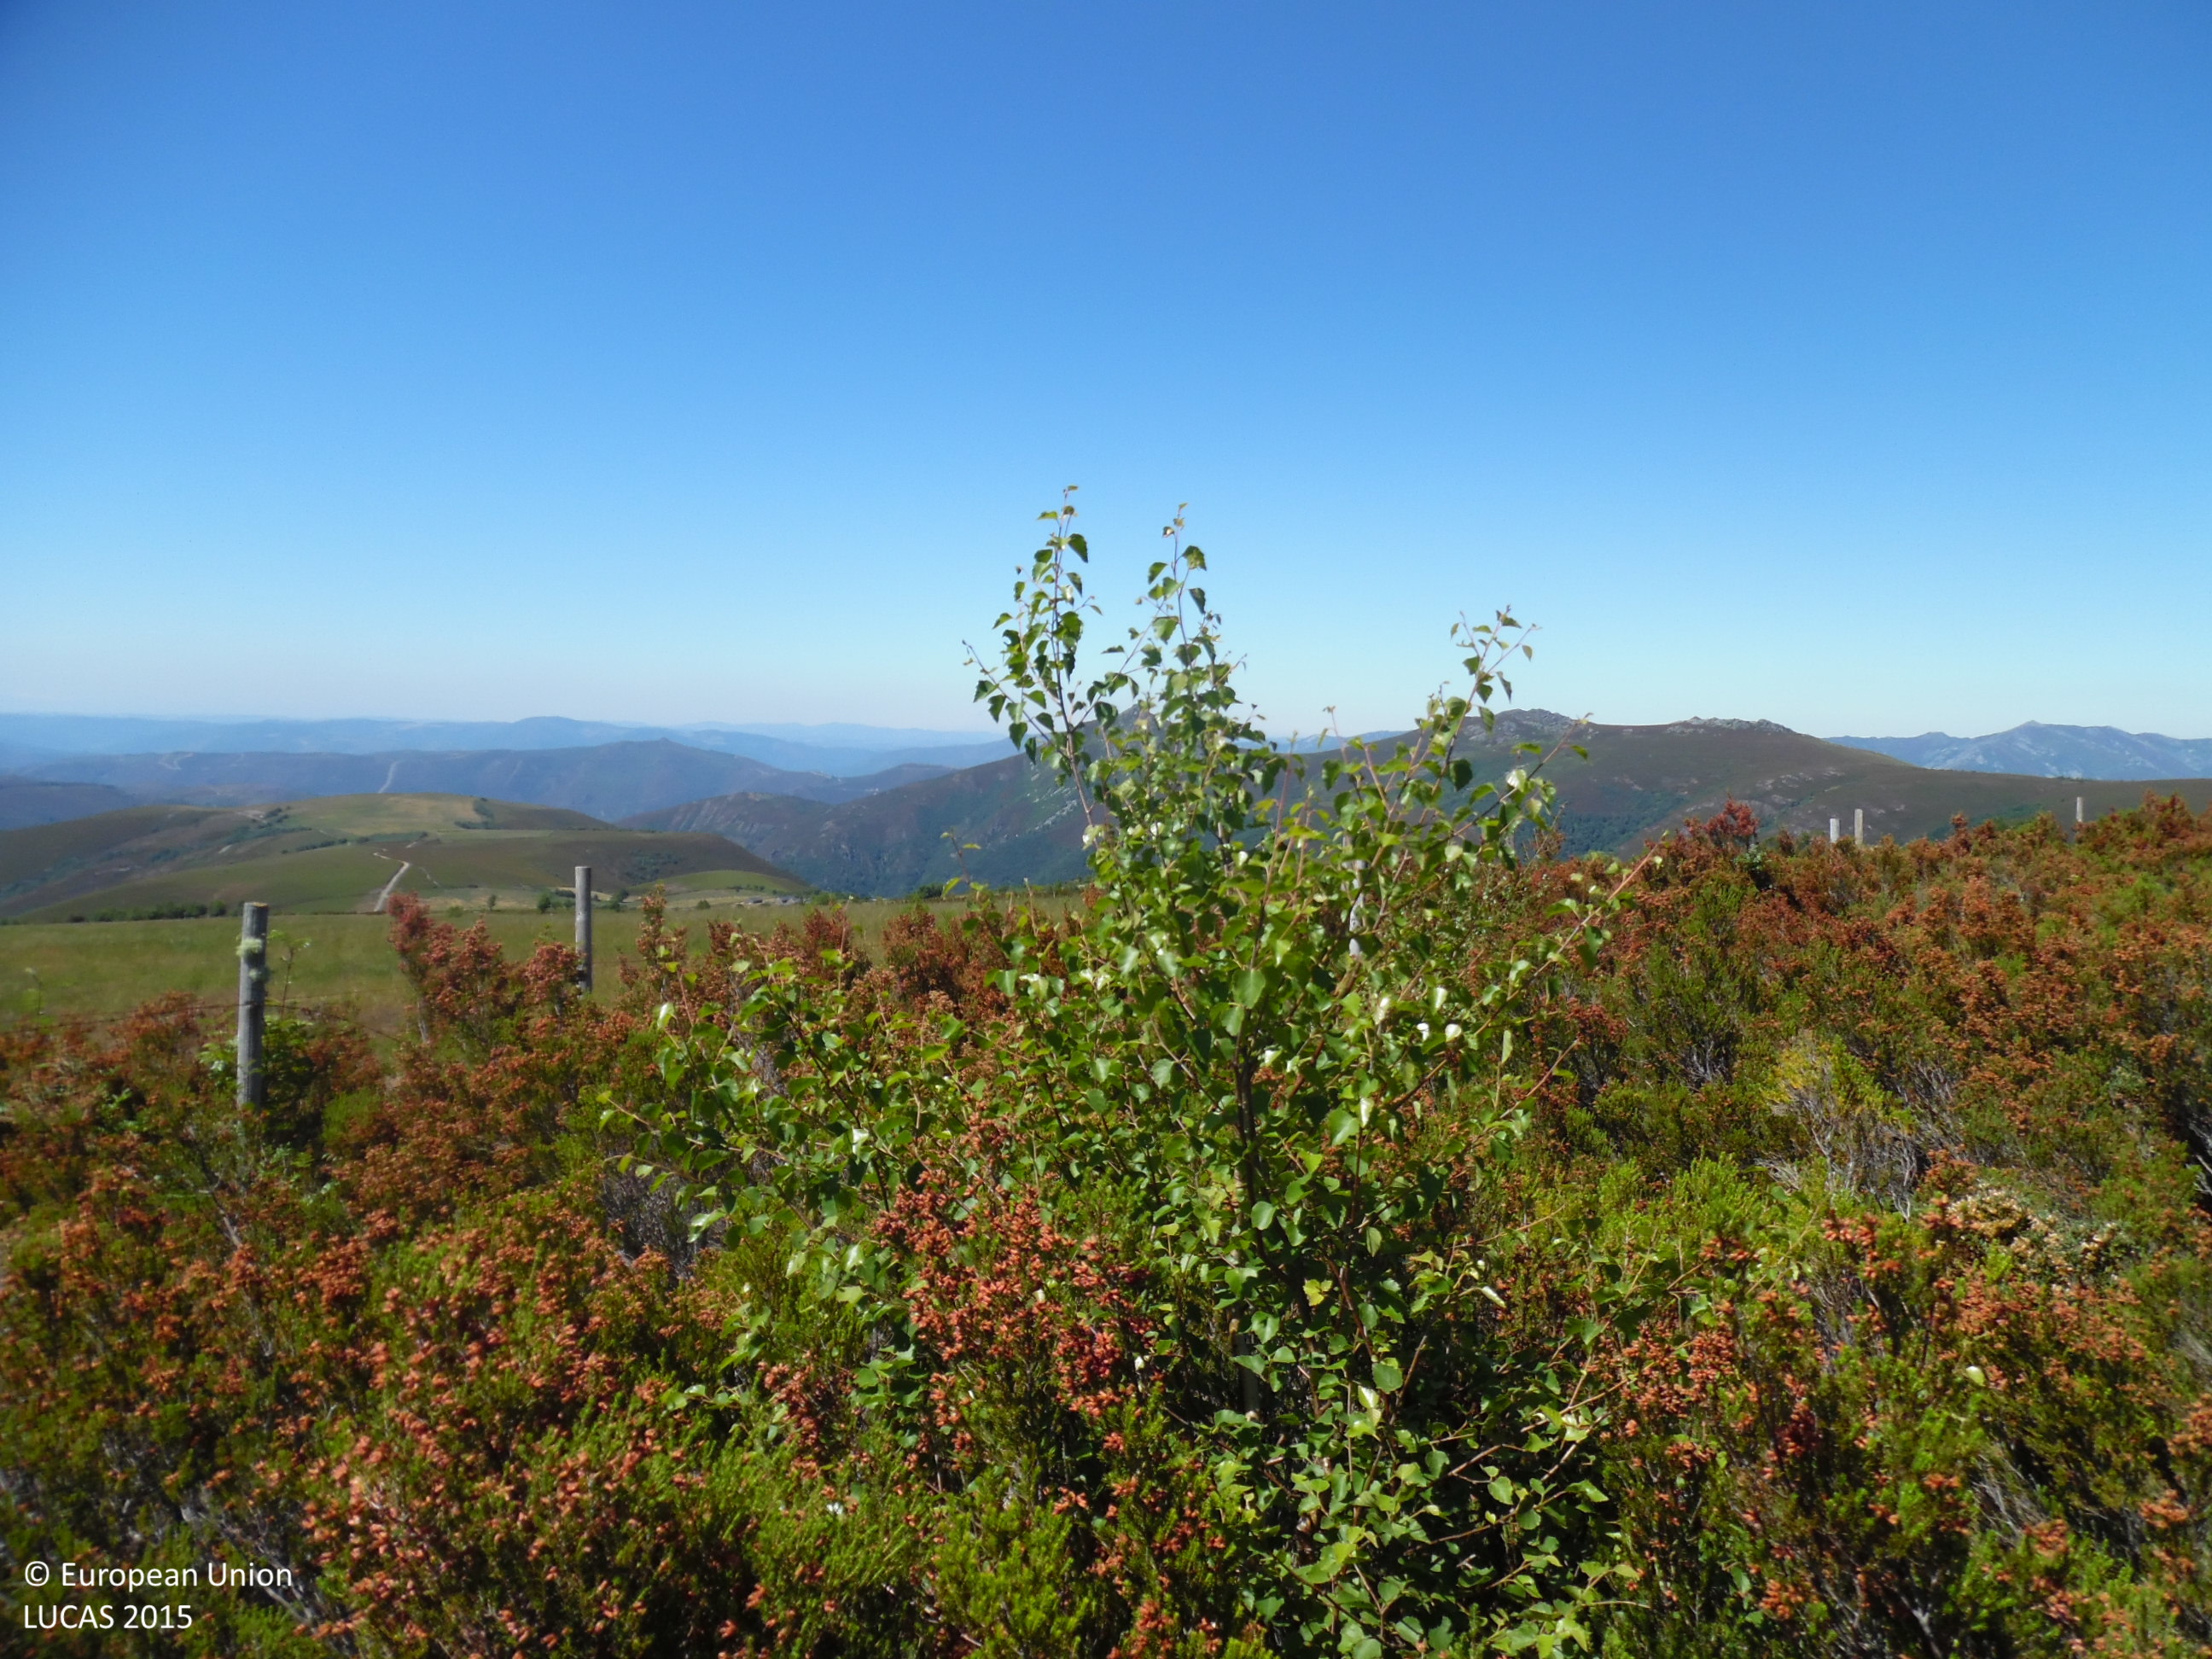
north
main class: Shrubland
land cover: Shrubland without tree cover
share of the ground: > 75 %
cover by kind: shrubs 95 %, herbaceous plants 5 %
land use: Semi-natural and natural areas not in use
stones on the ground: < 10 %
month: June
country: ES
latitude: 42.8879
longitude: -6.8440
